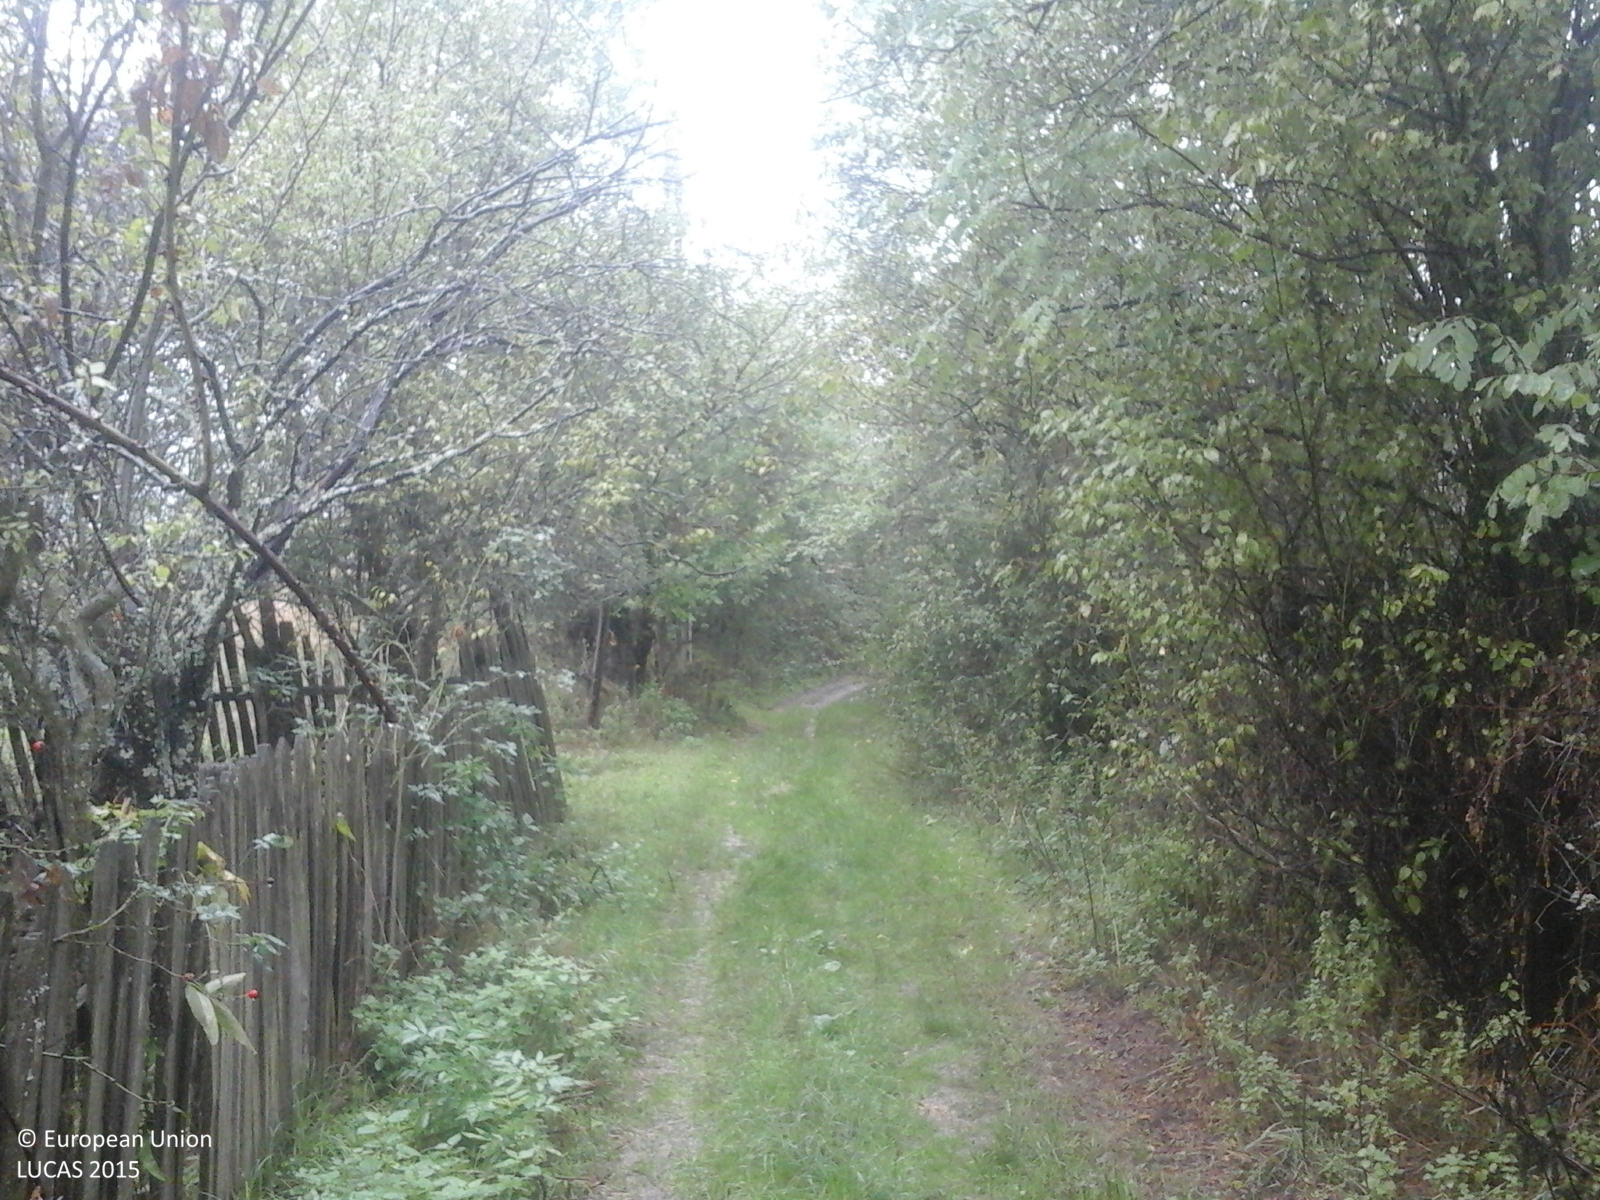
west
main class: Cropland
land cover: Vineyards
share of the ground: > 75 %
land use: Agriculture (excluding fallow land and kitchen gardens)
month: September
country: RO
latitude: 44.8332
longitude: 23.5022
